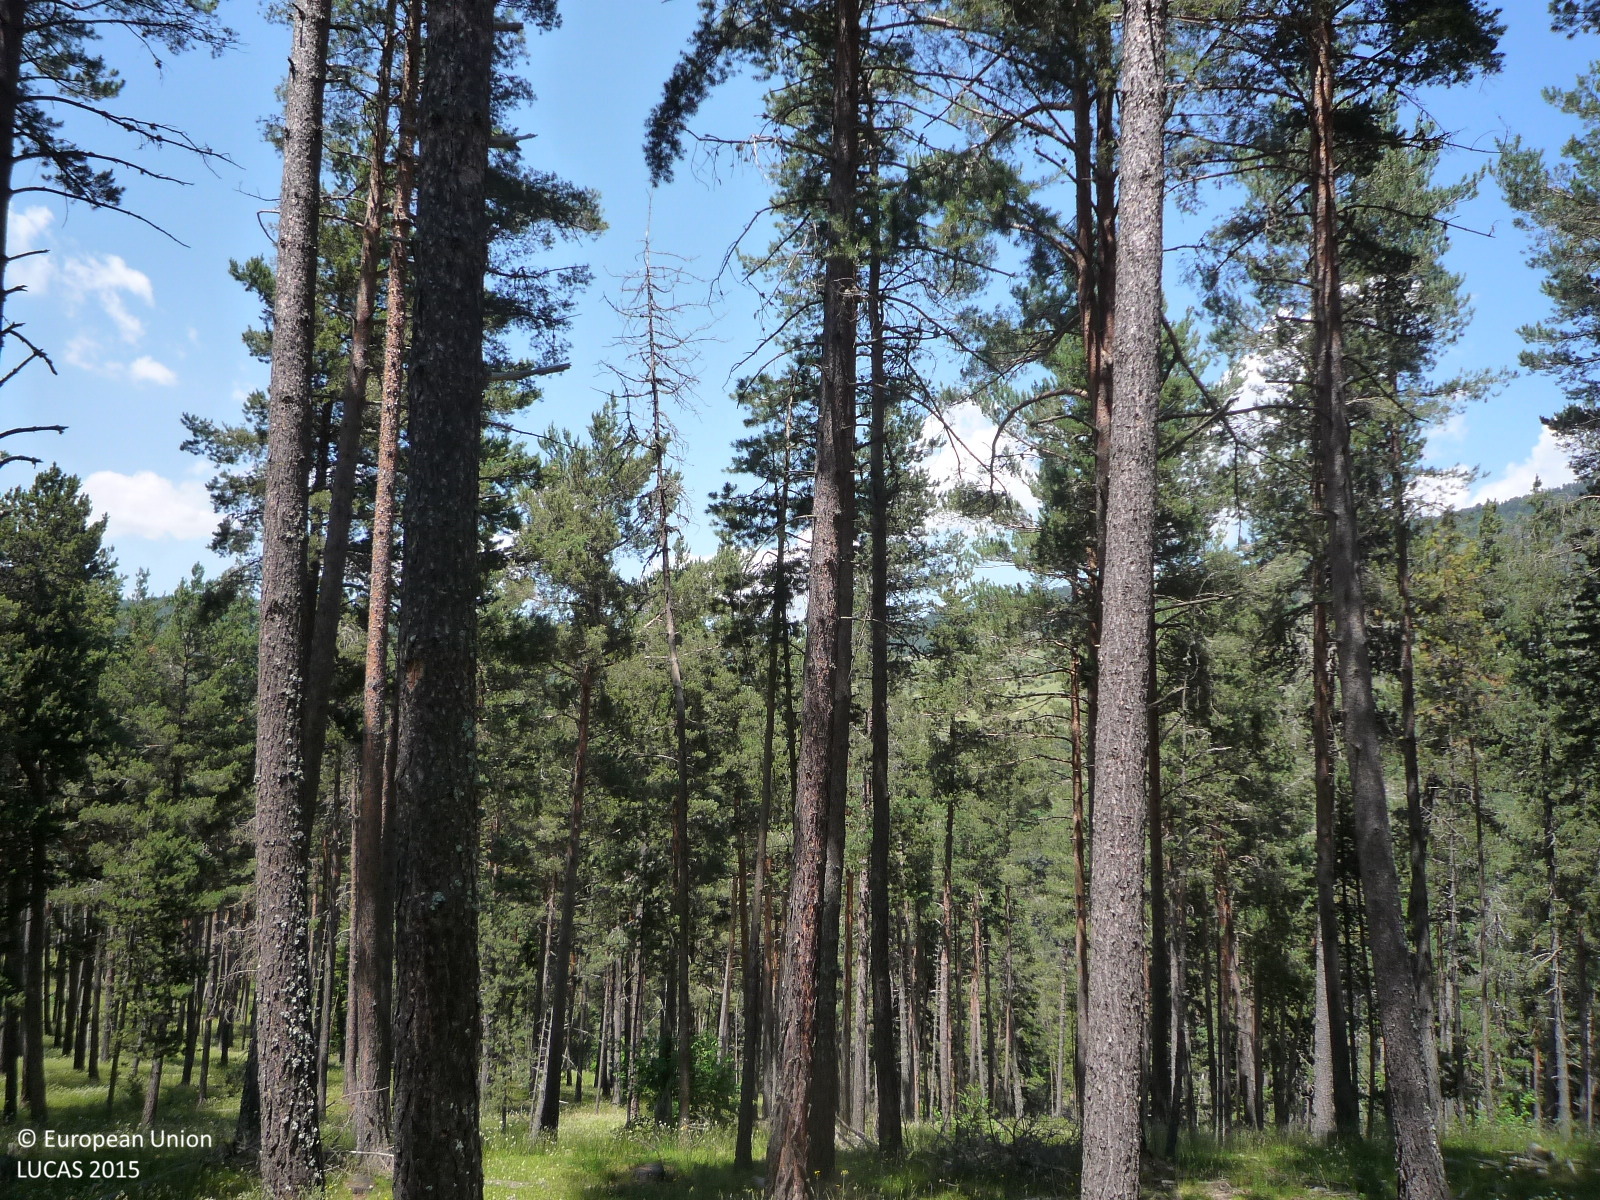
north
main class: Woodland
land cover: Pine dominated coniferous woodland
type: alpine coniferous forest
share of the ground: > 75 %
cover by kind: coniferous forest trees 90 %, herbaceous plants 10 %
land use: Forestry
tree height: > 5 m
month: June
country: ES
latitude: 42.3524
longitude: 1.9629
